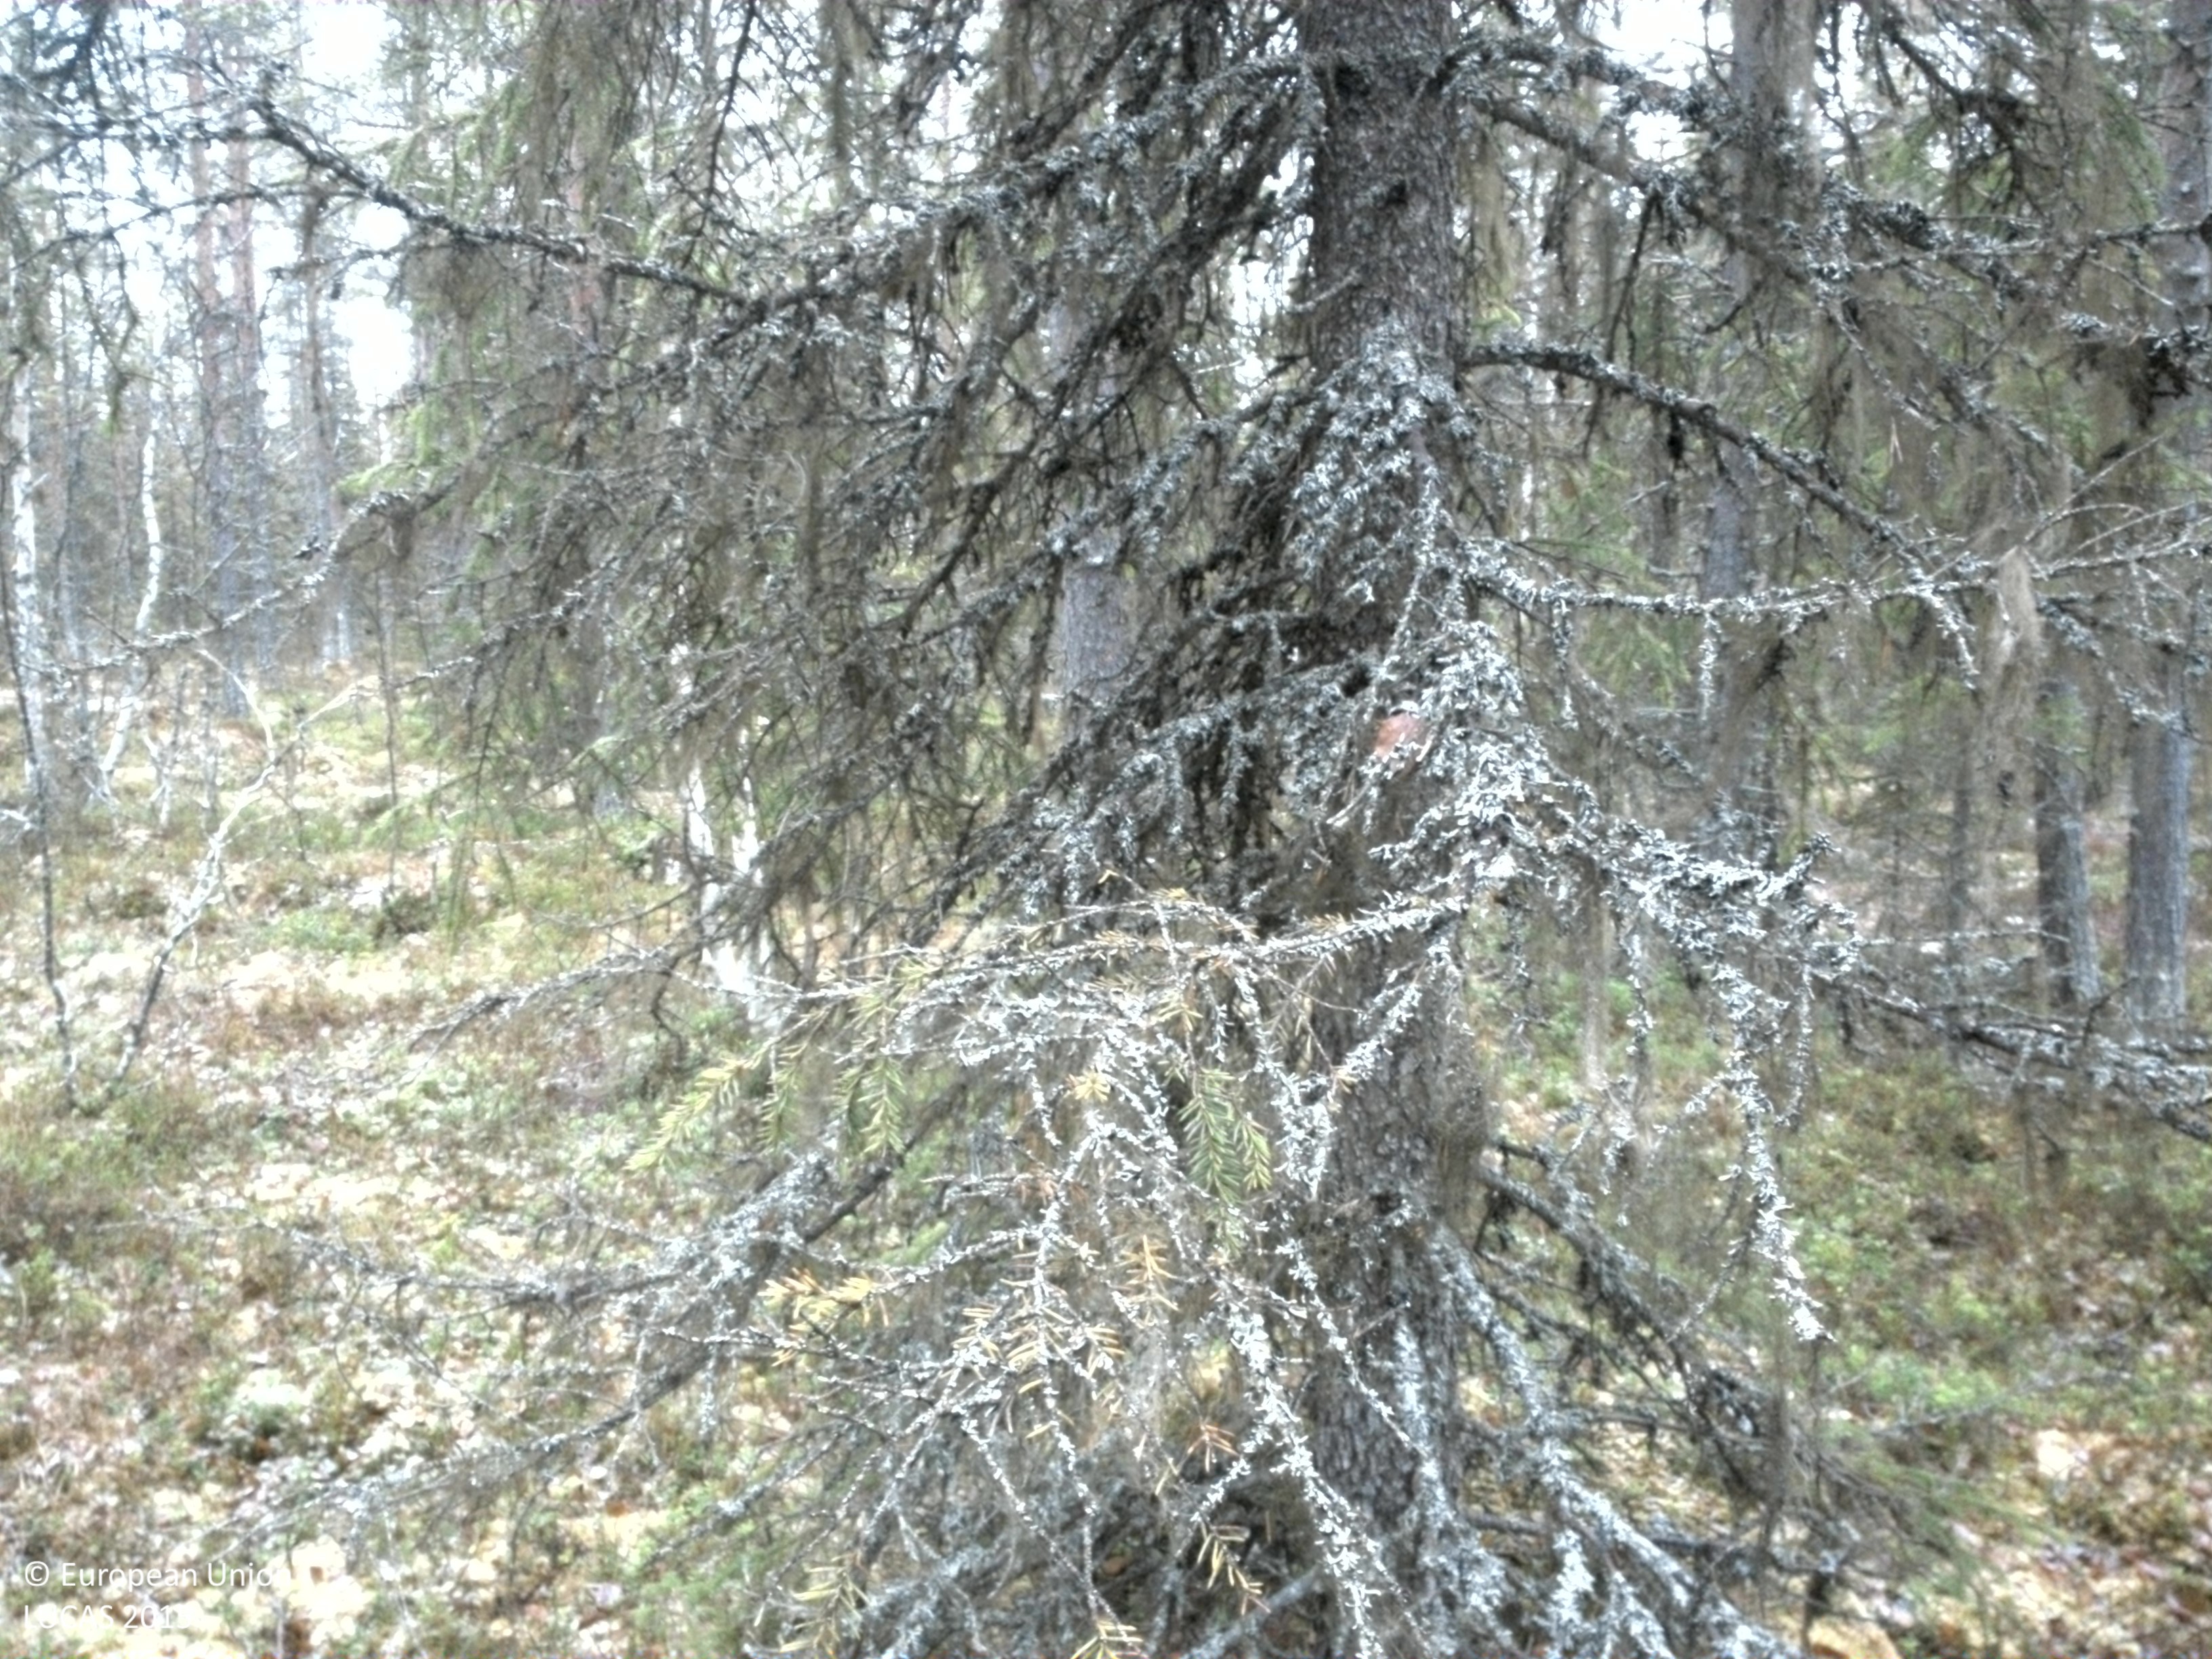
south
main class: Woodland
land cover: Other coniferous woodland
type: boreal forest
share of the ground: 25 - 50 %
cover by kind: coniferous forest trees 35 %, shrubs 35 %, lichens and mosses 20 %, broadleaved forest trees 5 %, herbaceous plants 5 %
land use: Forestry
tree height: > 5 m
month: October
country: SE
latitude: 64.3636
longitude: 16.7423
